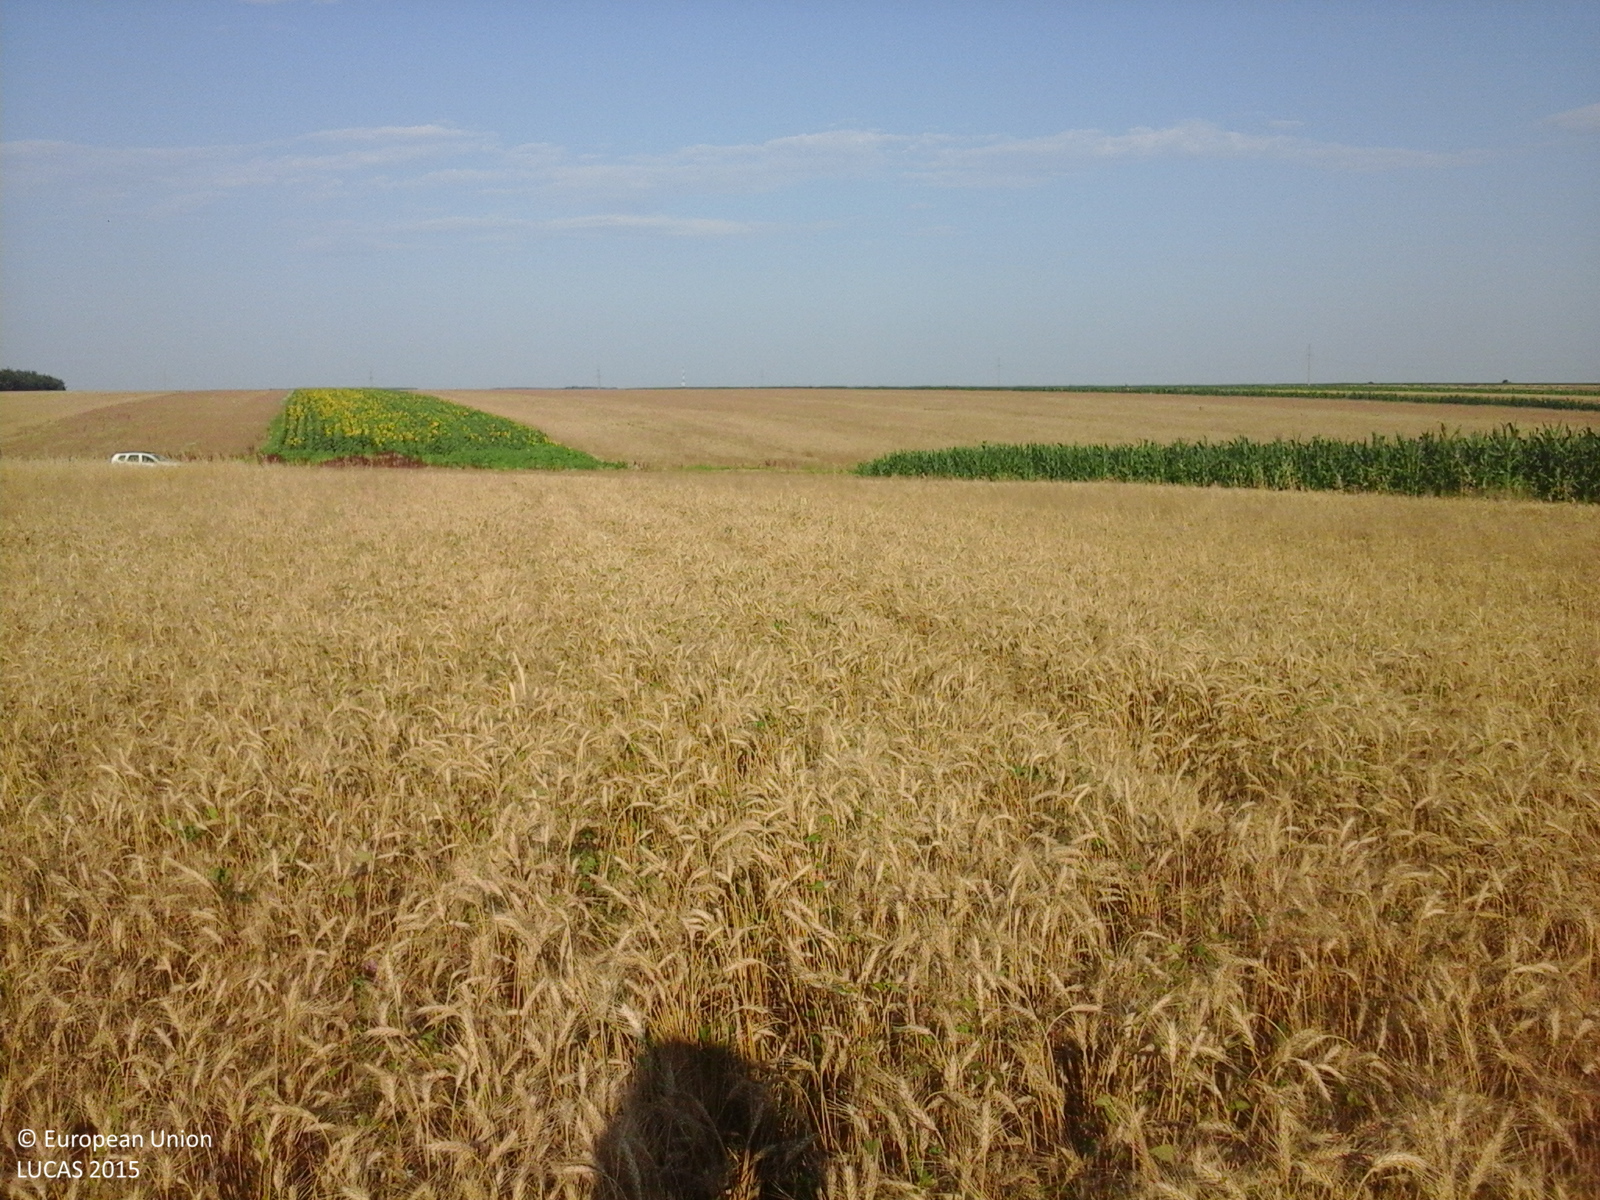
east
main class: Cropland
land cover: Common wheat
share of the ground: > 75 %
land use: Agriculture (excluding fallow land and kitchen gardens)
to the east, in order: Common wheat; Tracks; Spontaneously vegetated surfaces; Sunflower; Common wheat
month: July
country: RO
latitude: 44.5788
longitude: 24.5687
